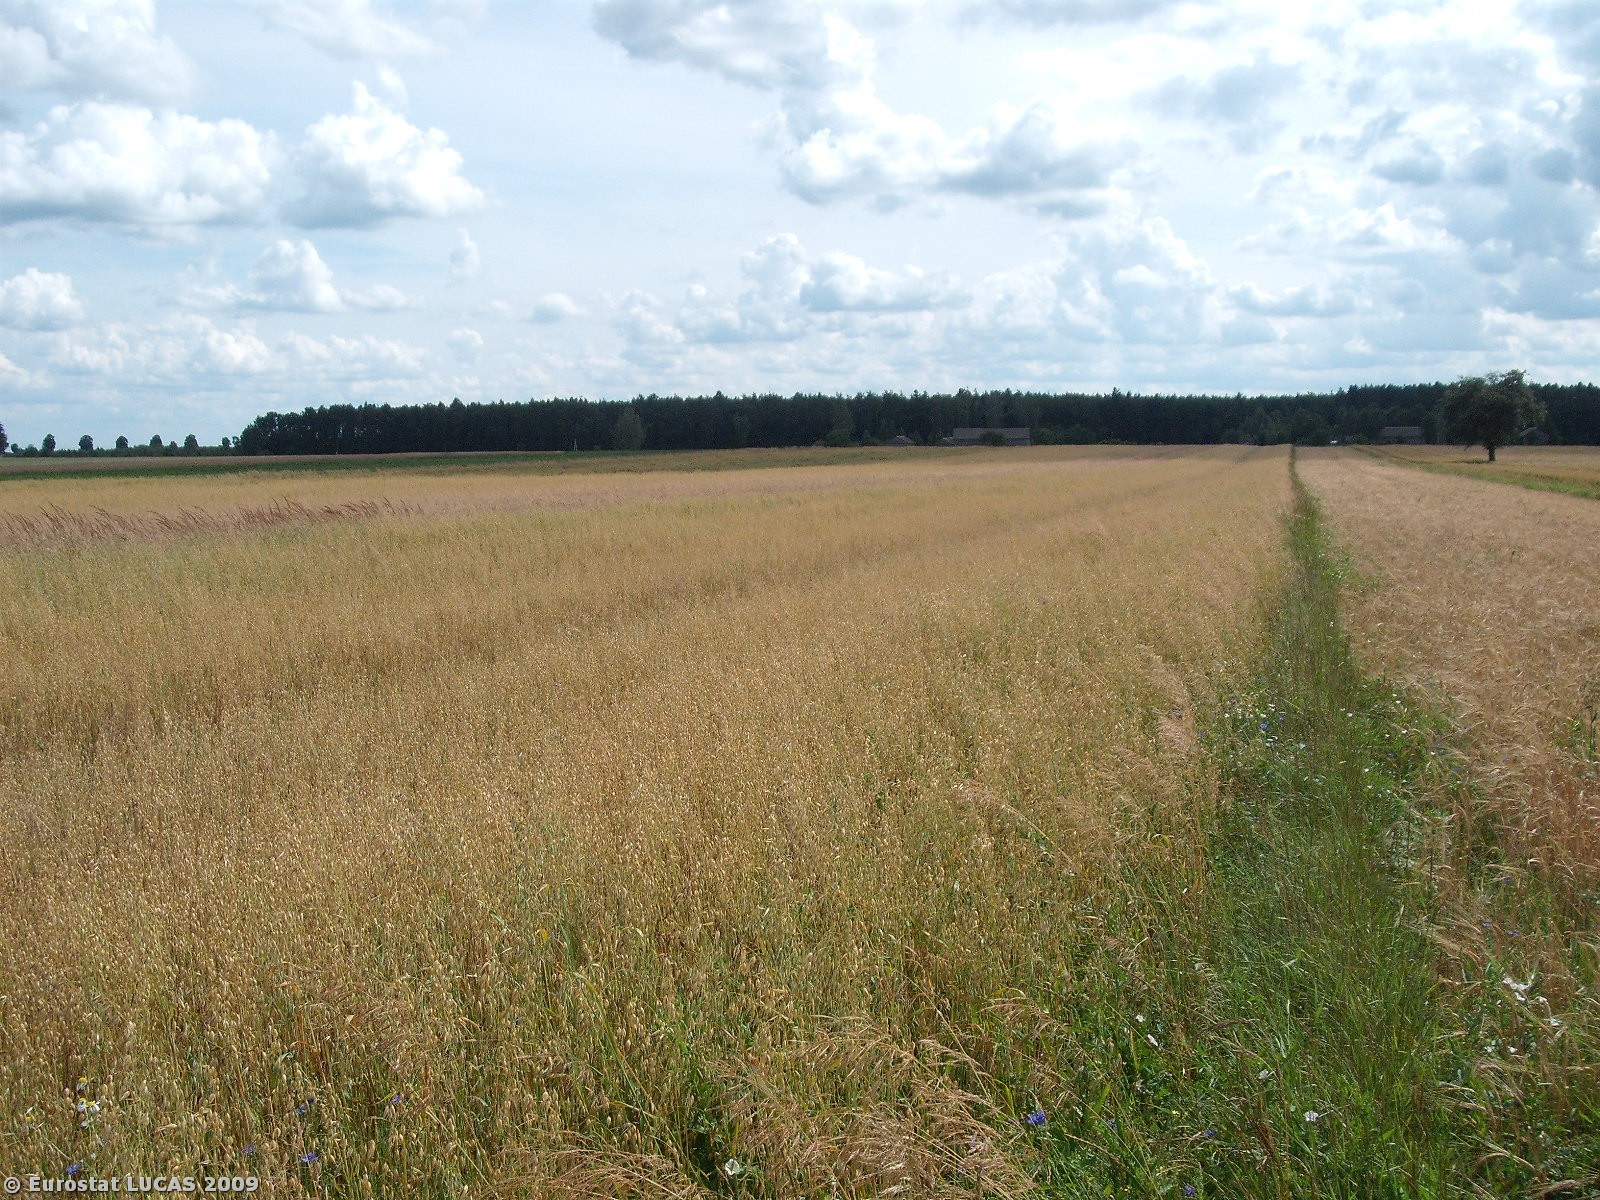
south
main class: Cropland
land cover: Oats
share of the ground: > 75 %
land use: Agriculture (excluding fallow land and kitchen gardens)
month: July
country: PL
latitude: 51.1050
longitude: 21.3461
